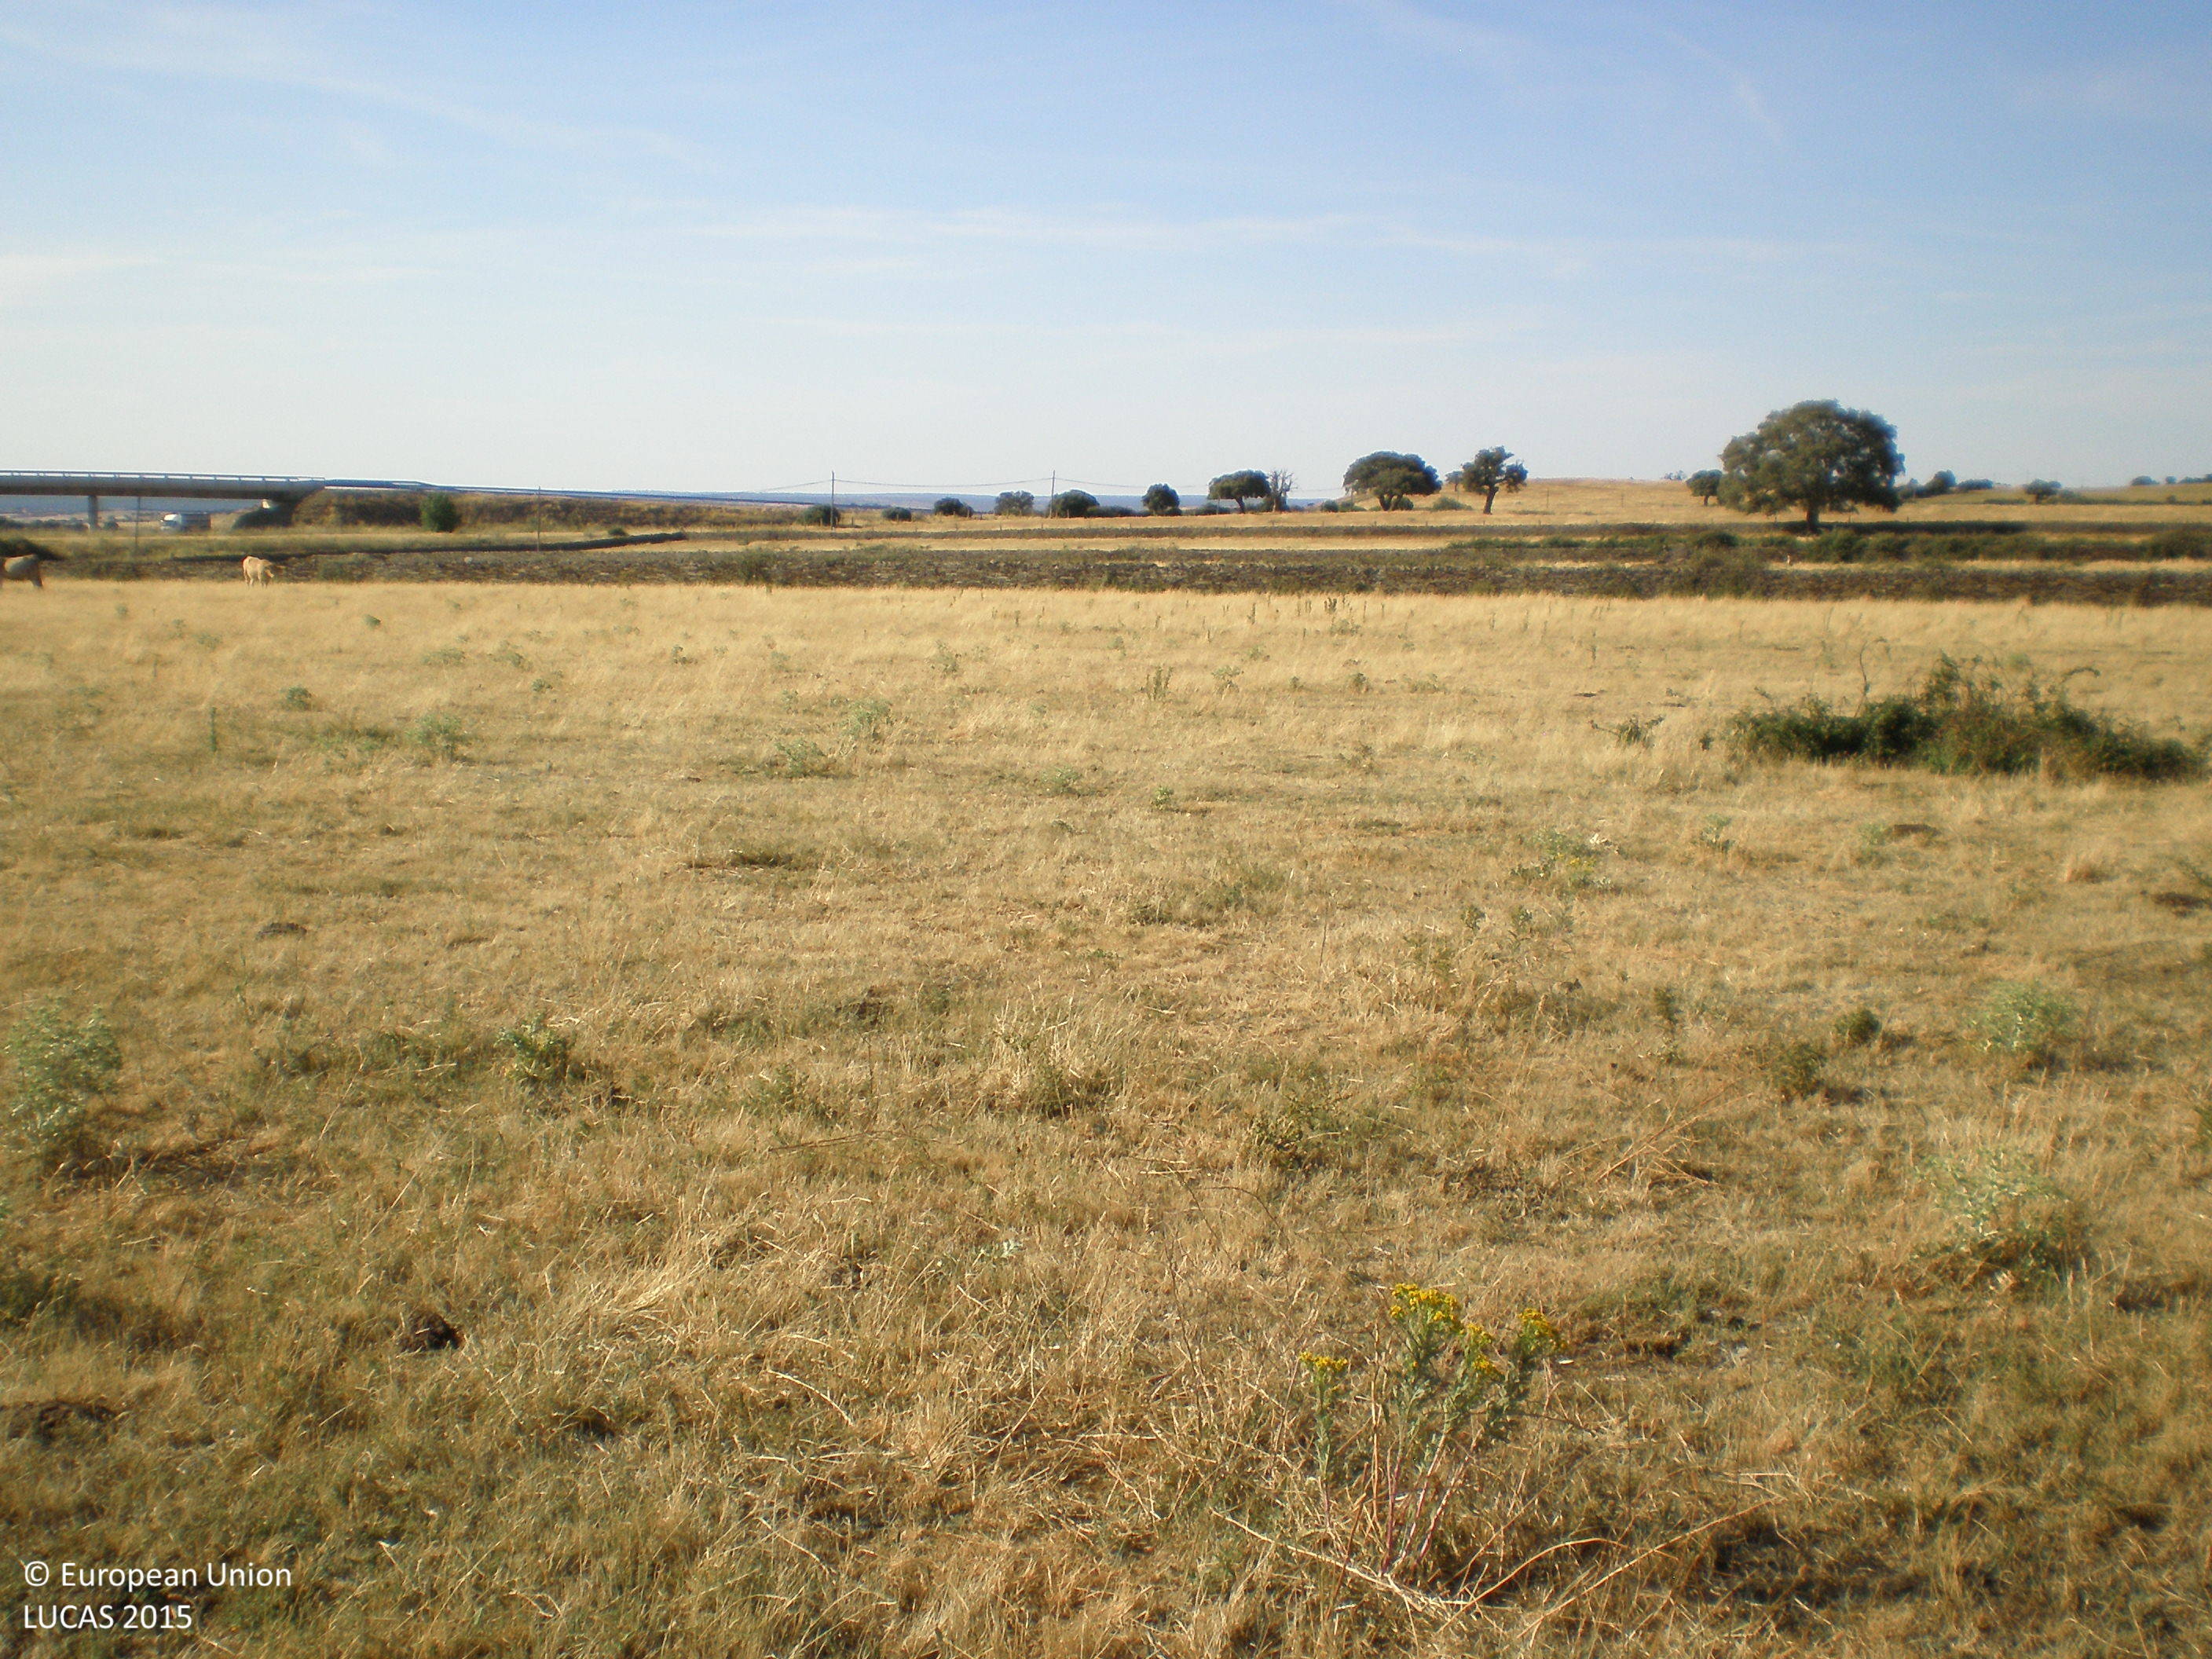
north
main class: Grassland
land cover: Grassland without tree/shrub cover
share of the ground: > 75 %
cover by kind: herbaceous plants 100 %
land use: Agriculture (excluding fallow land and kitchen gardens)
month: July
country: ES
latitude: 40.5830
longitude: -5.6546
